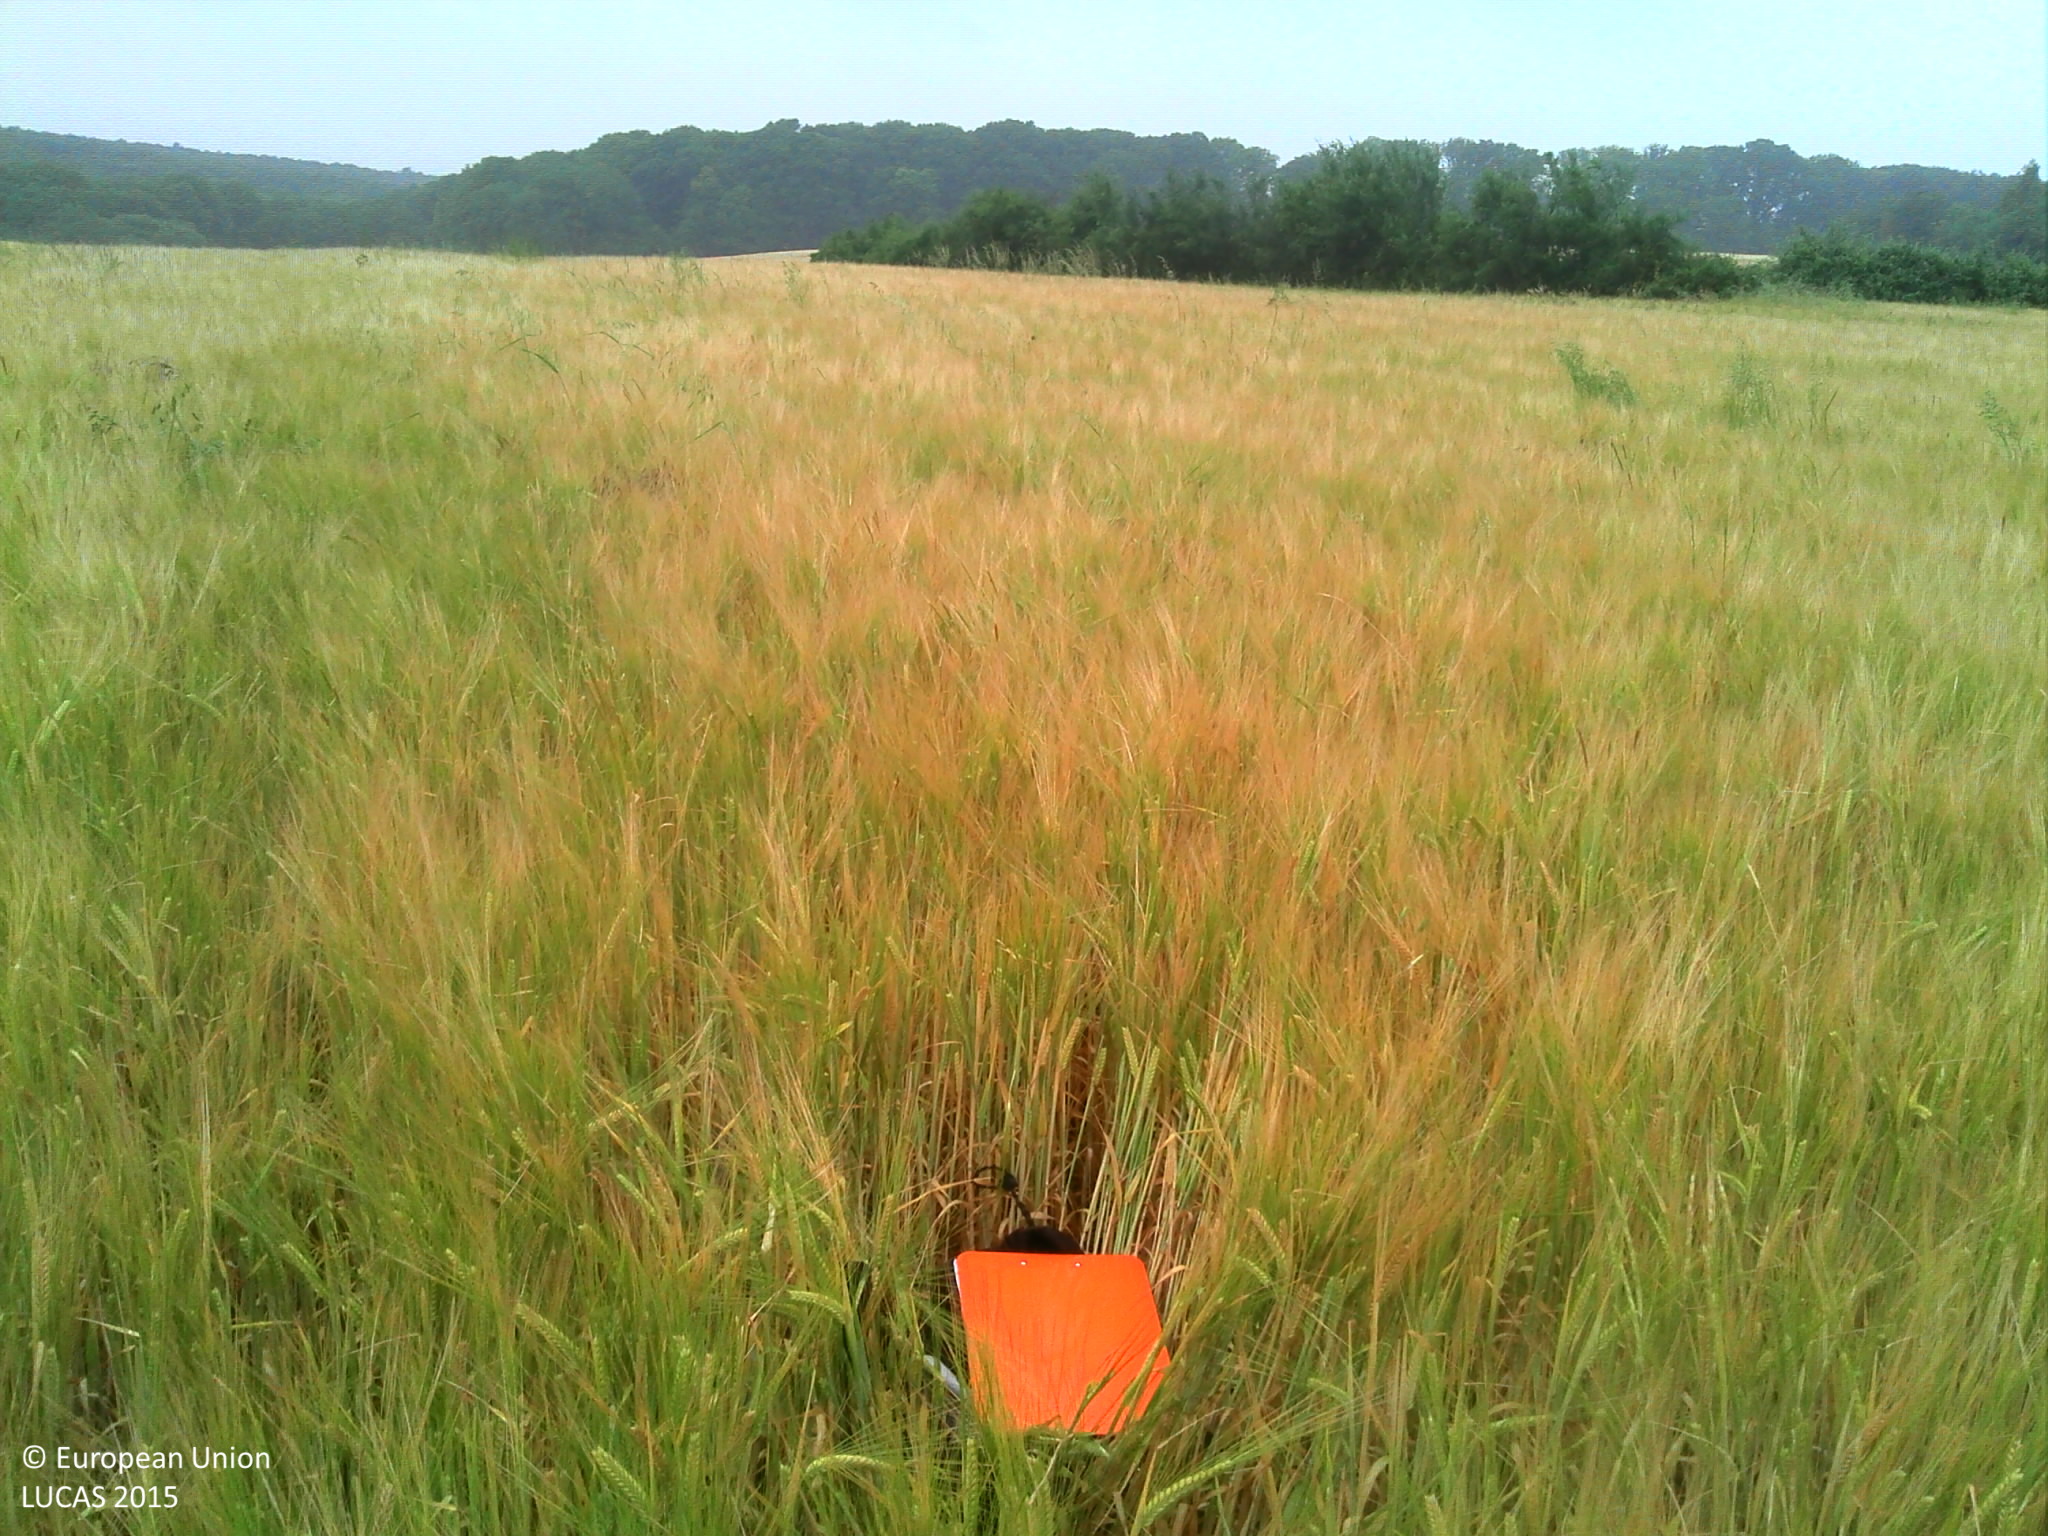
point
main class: Cropland
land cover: Barley
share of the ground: > 75 %
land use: Agriculture (excluding fallow land and kitchen gardens)
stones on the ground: < 10 %
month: June
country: FR
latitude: 47.2902
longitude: 3.1859
